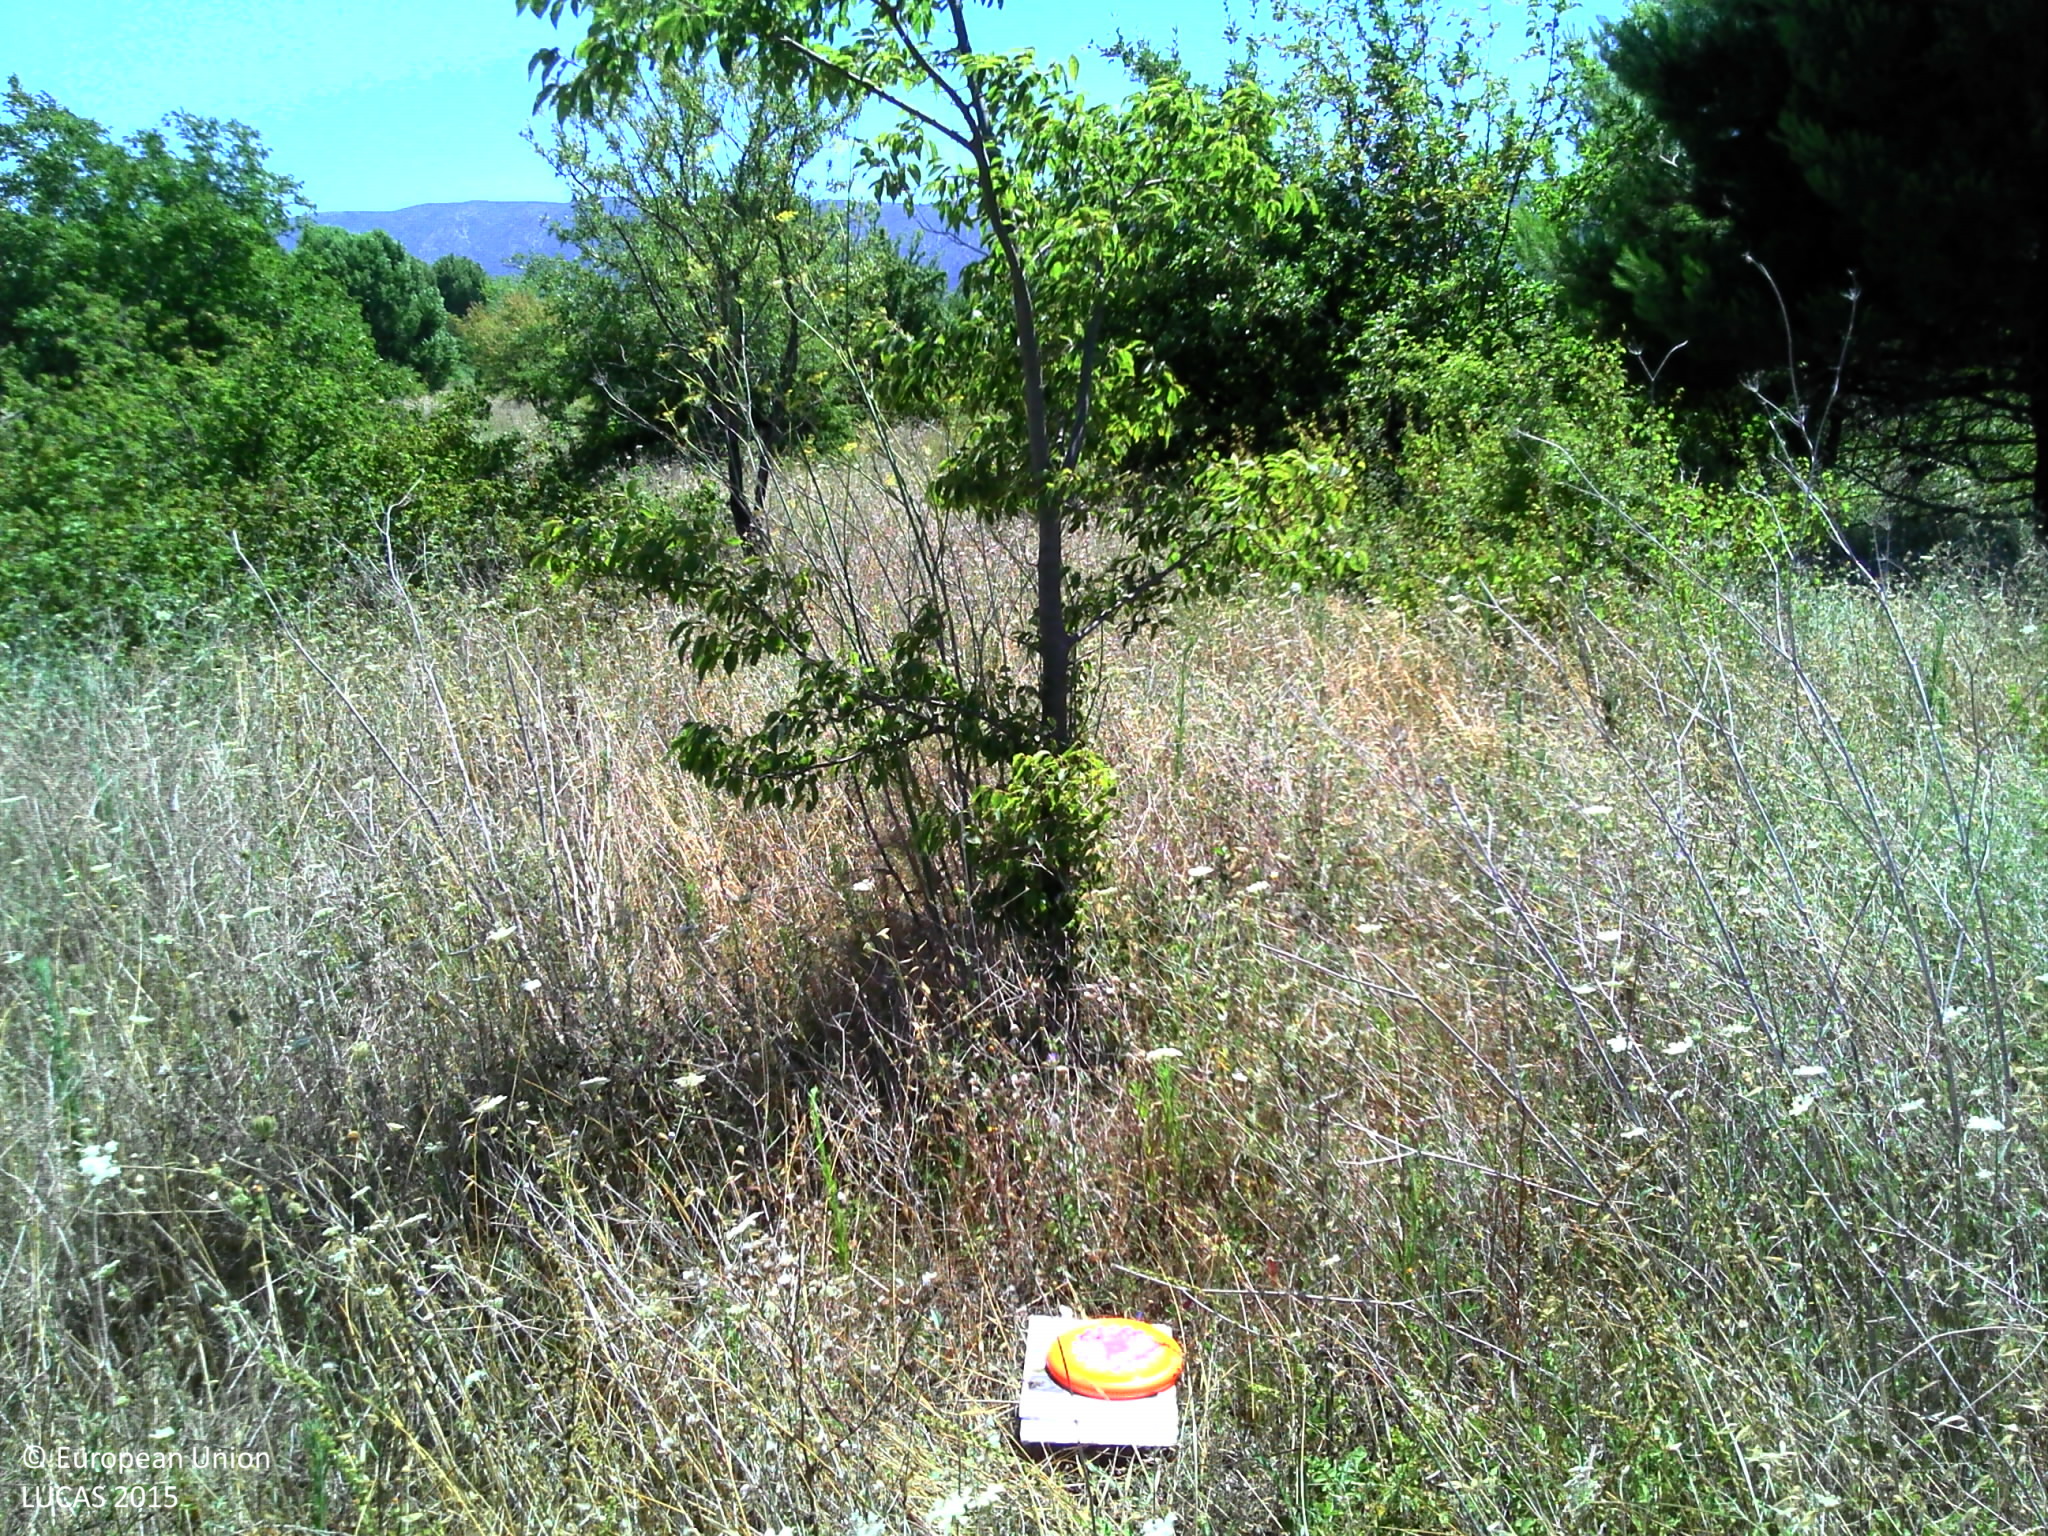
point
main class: Shrubland
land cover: Shrubland with sparse tree cover
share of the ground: > 75 %
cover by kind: herbaceous plants 60 %, shrubs 30 %, broadleaved forest trees 5 %, unconsolidated bare surface 5 %
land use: Semi-natural and natural areas not in use
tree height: < 5 m
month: July
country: FR
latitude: 43.8755
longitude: 5.1428
